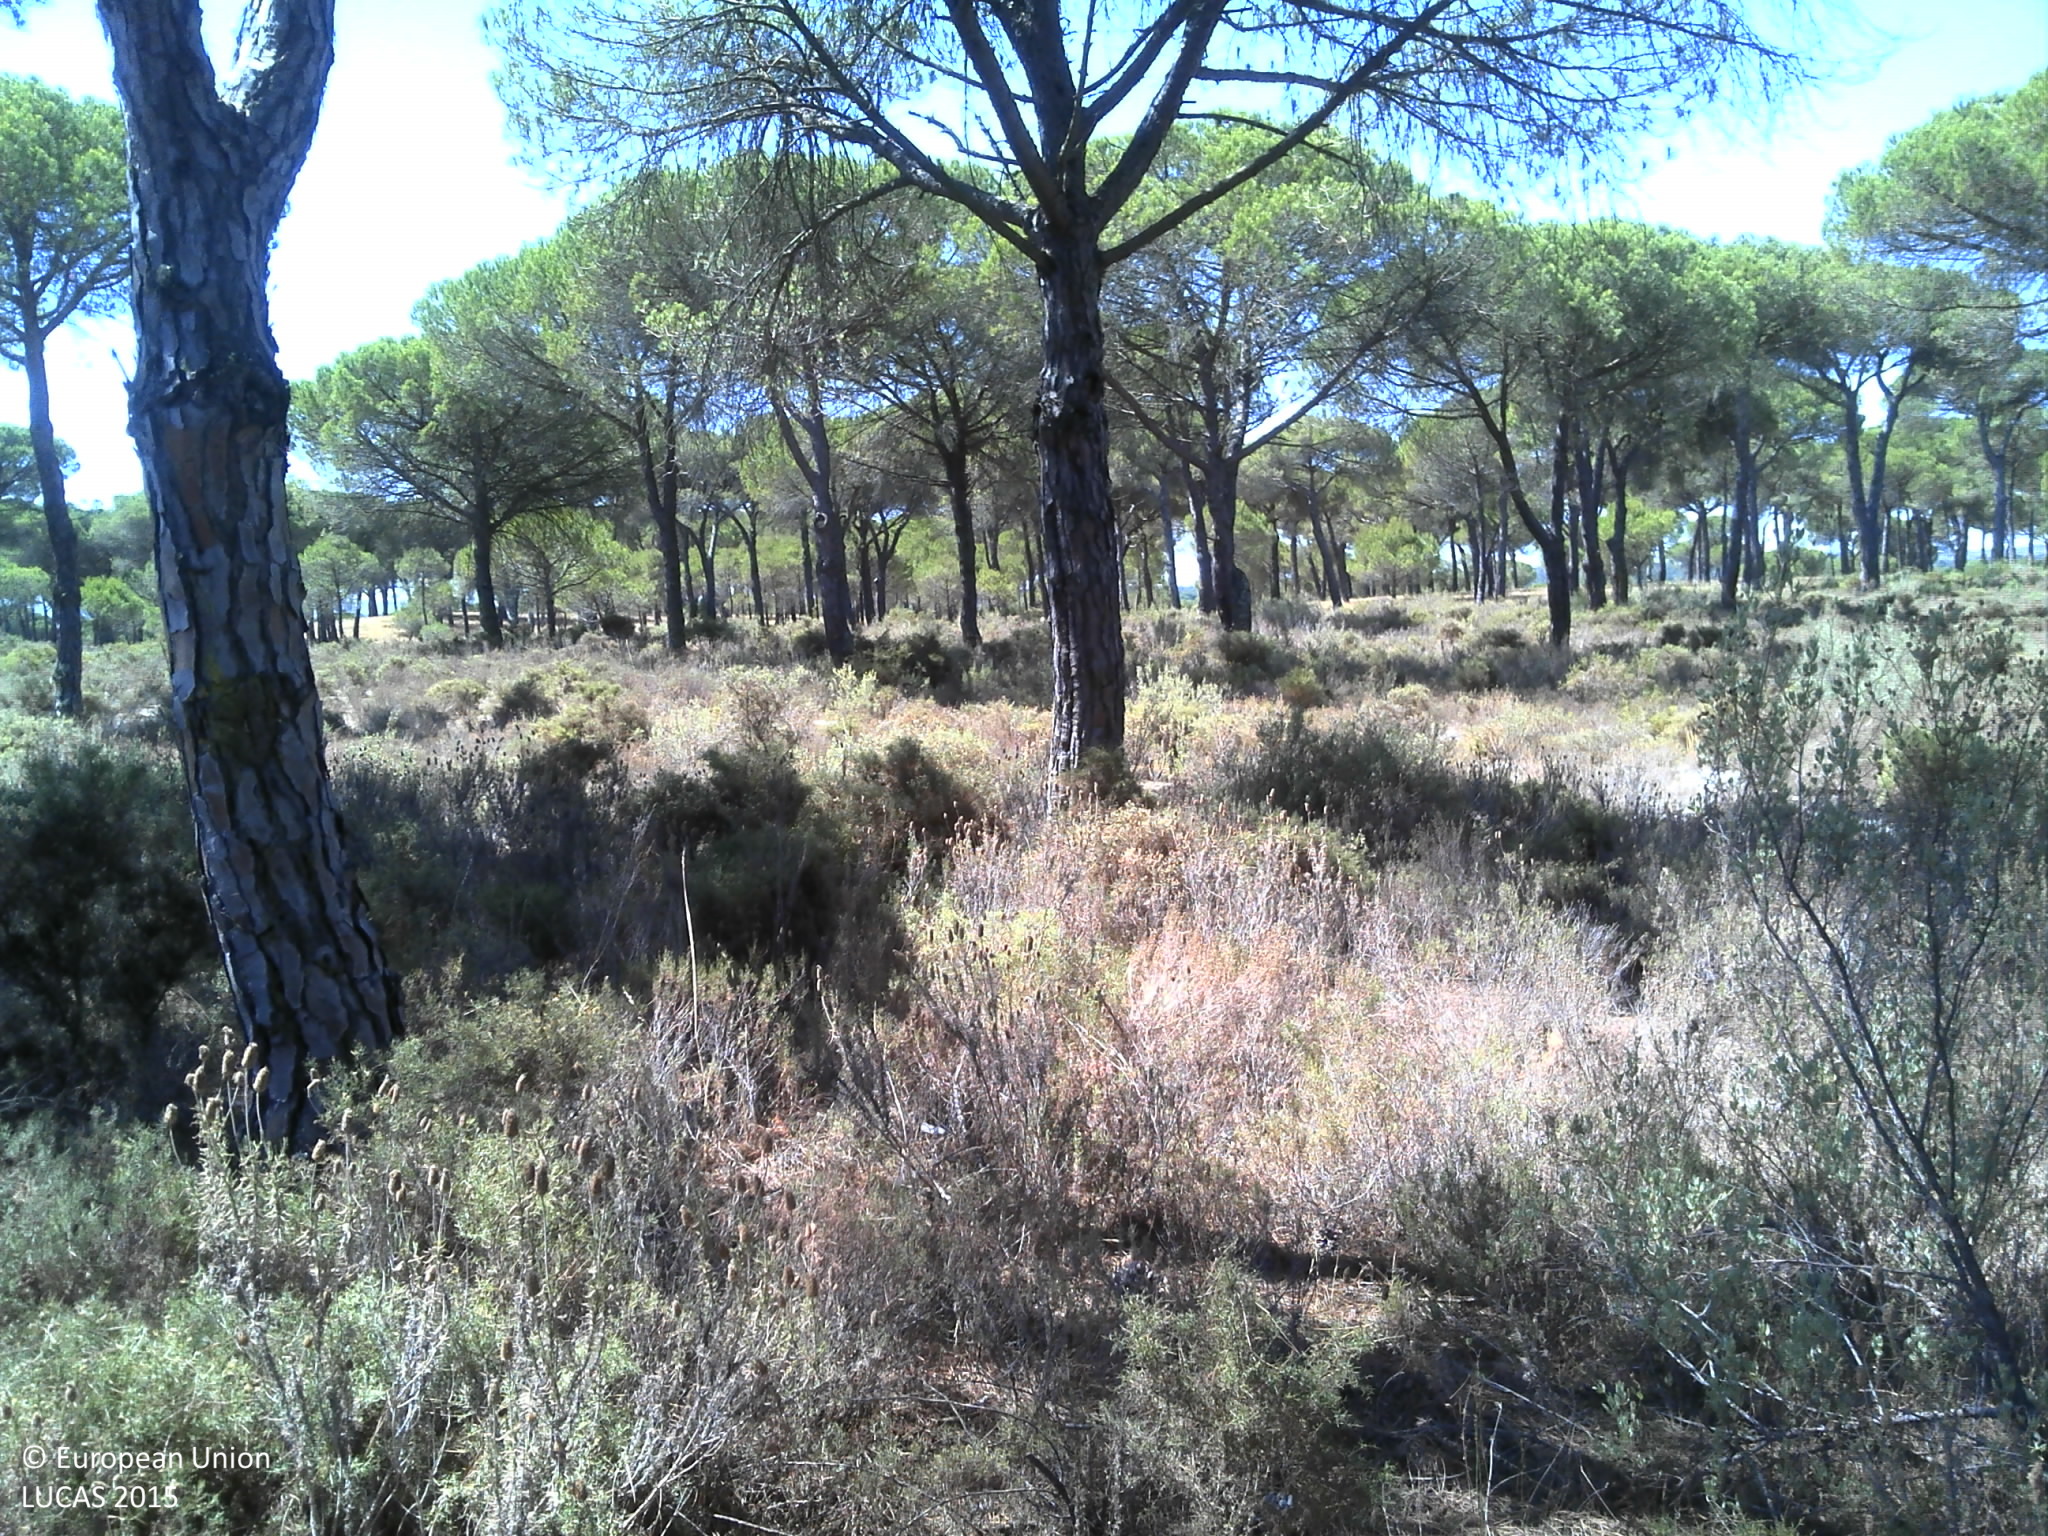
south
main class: Woodland
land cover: Pine dominated coniferous woodland
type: coniferous forest of the mediterranean region
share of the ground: 50 - 75 %
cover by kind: coniferous forest trees 60 %, shrubs 20 %, unconsolidated bare surface 20 %
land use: Forestry
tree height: > 5 m
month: July
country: PT
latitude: 38.3019
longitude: -8.7052
